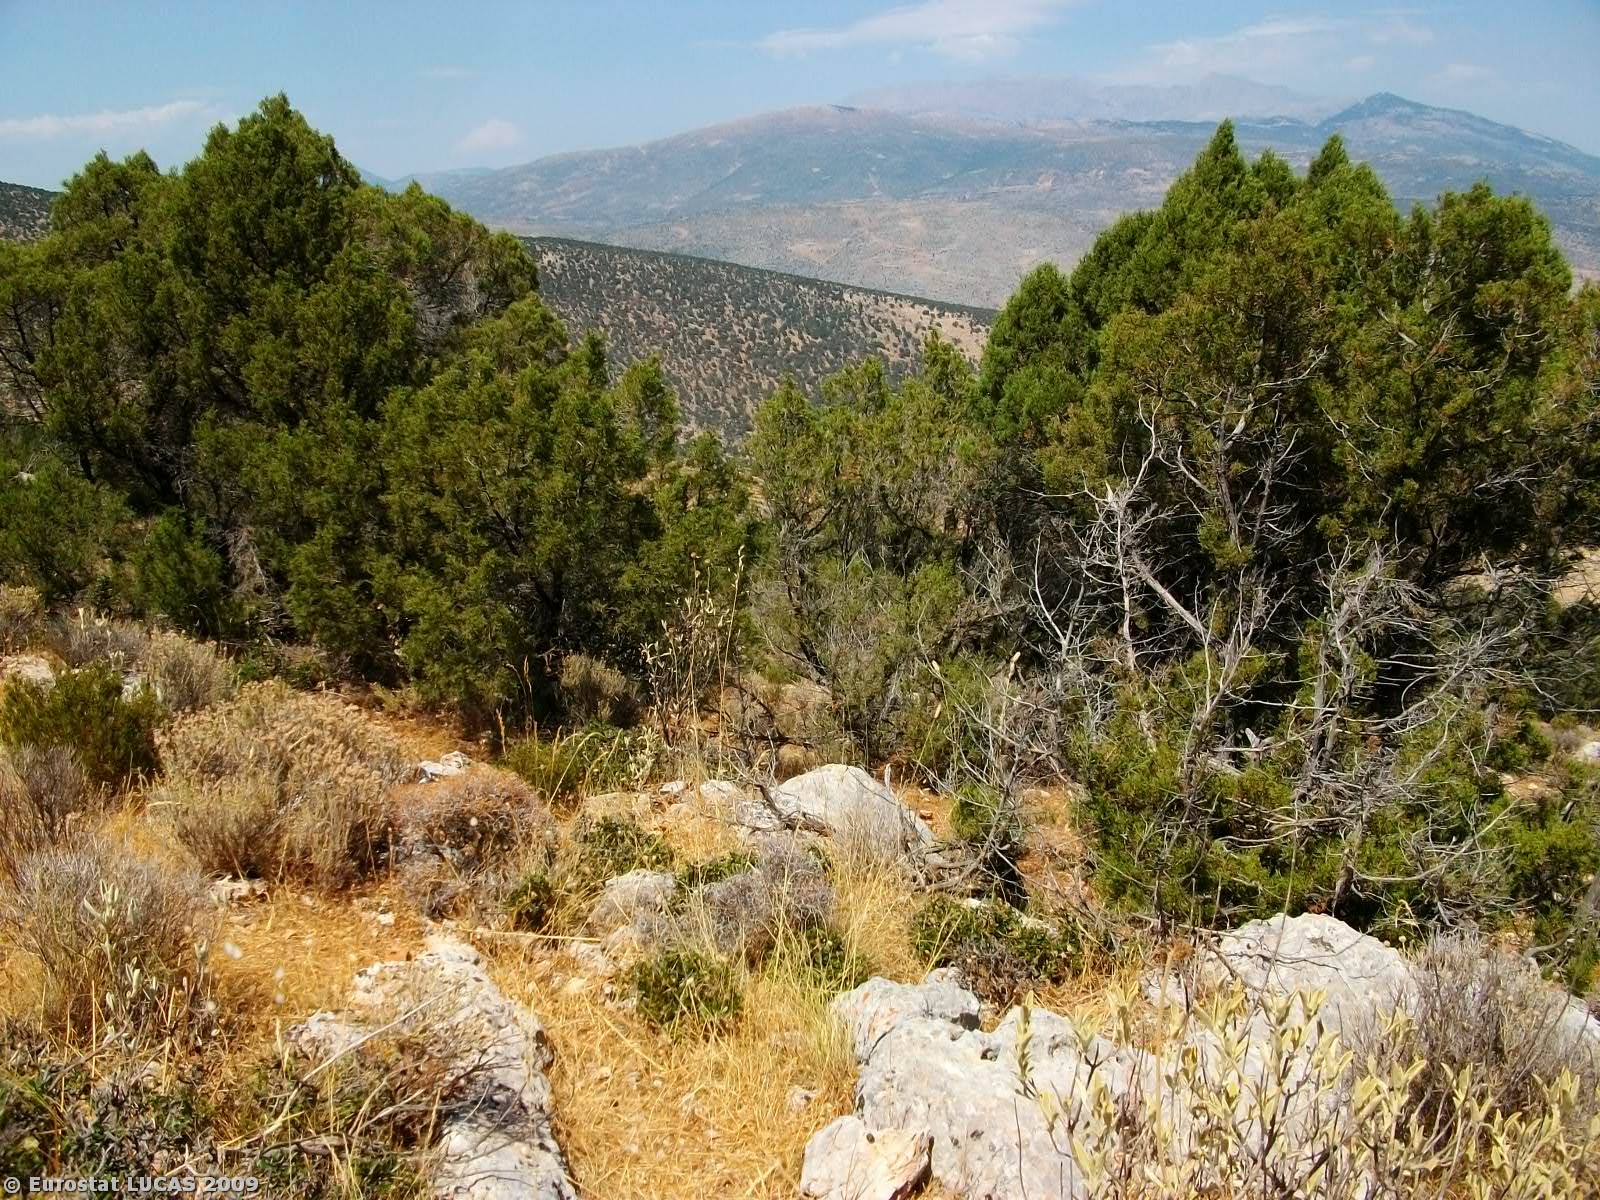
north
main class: Woodland
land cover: Coniferous woodland
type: coniferous forest of the mediterranean region
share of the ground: 50 - 75 %
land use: Forestry
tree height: > 5 m
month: August
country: GR
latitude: 38.3389
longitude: 22.5710
